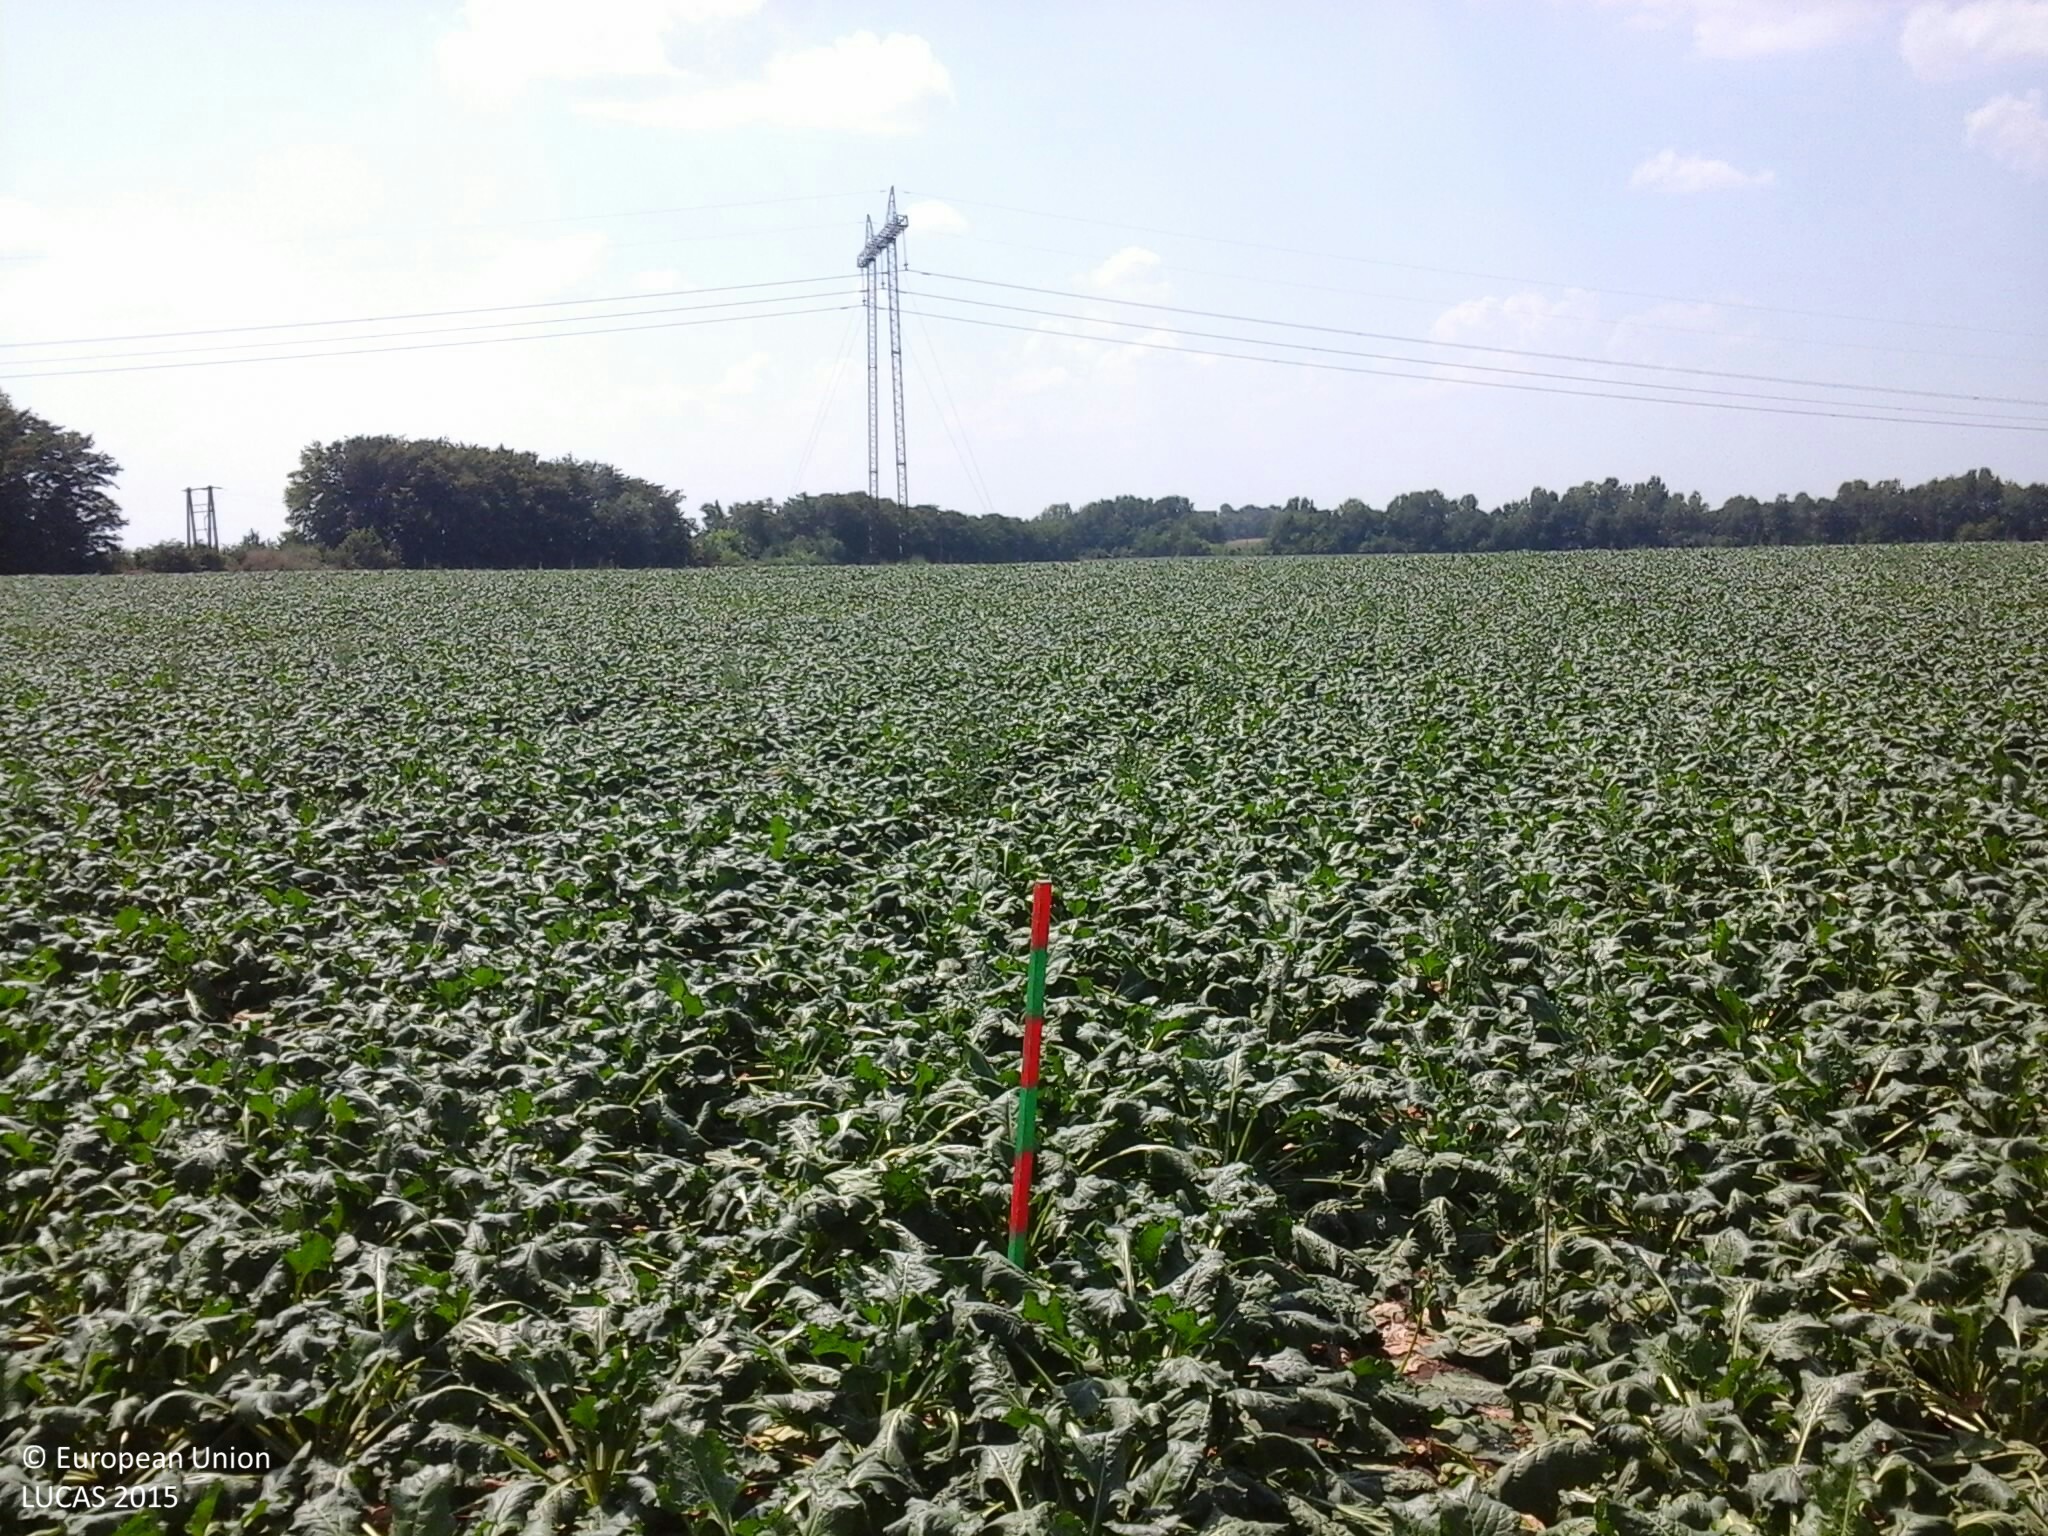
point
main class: Cropland
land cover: Sugar beet
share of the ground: > 75 %
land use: Agriculture (excluding fallow land and kitchen gardens)
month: August
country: HU
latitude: 46.9333
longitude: 18.2987
